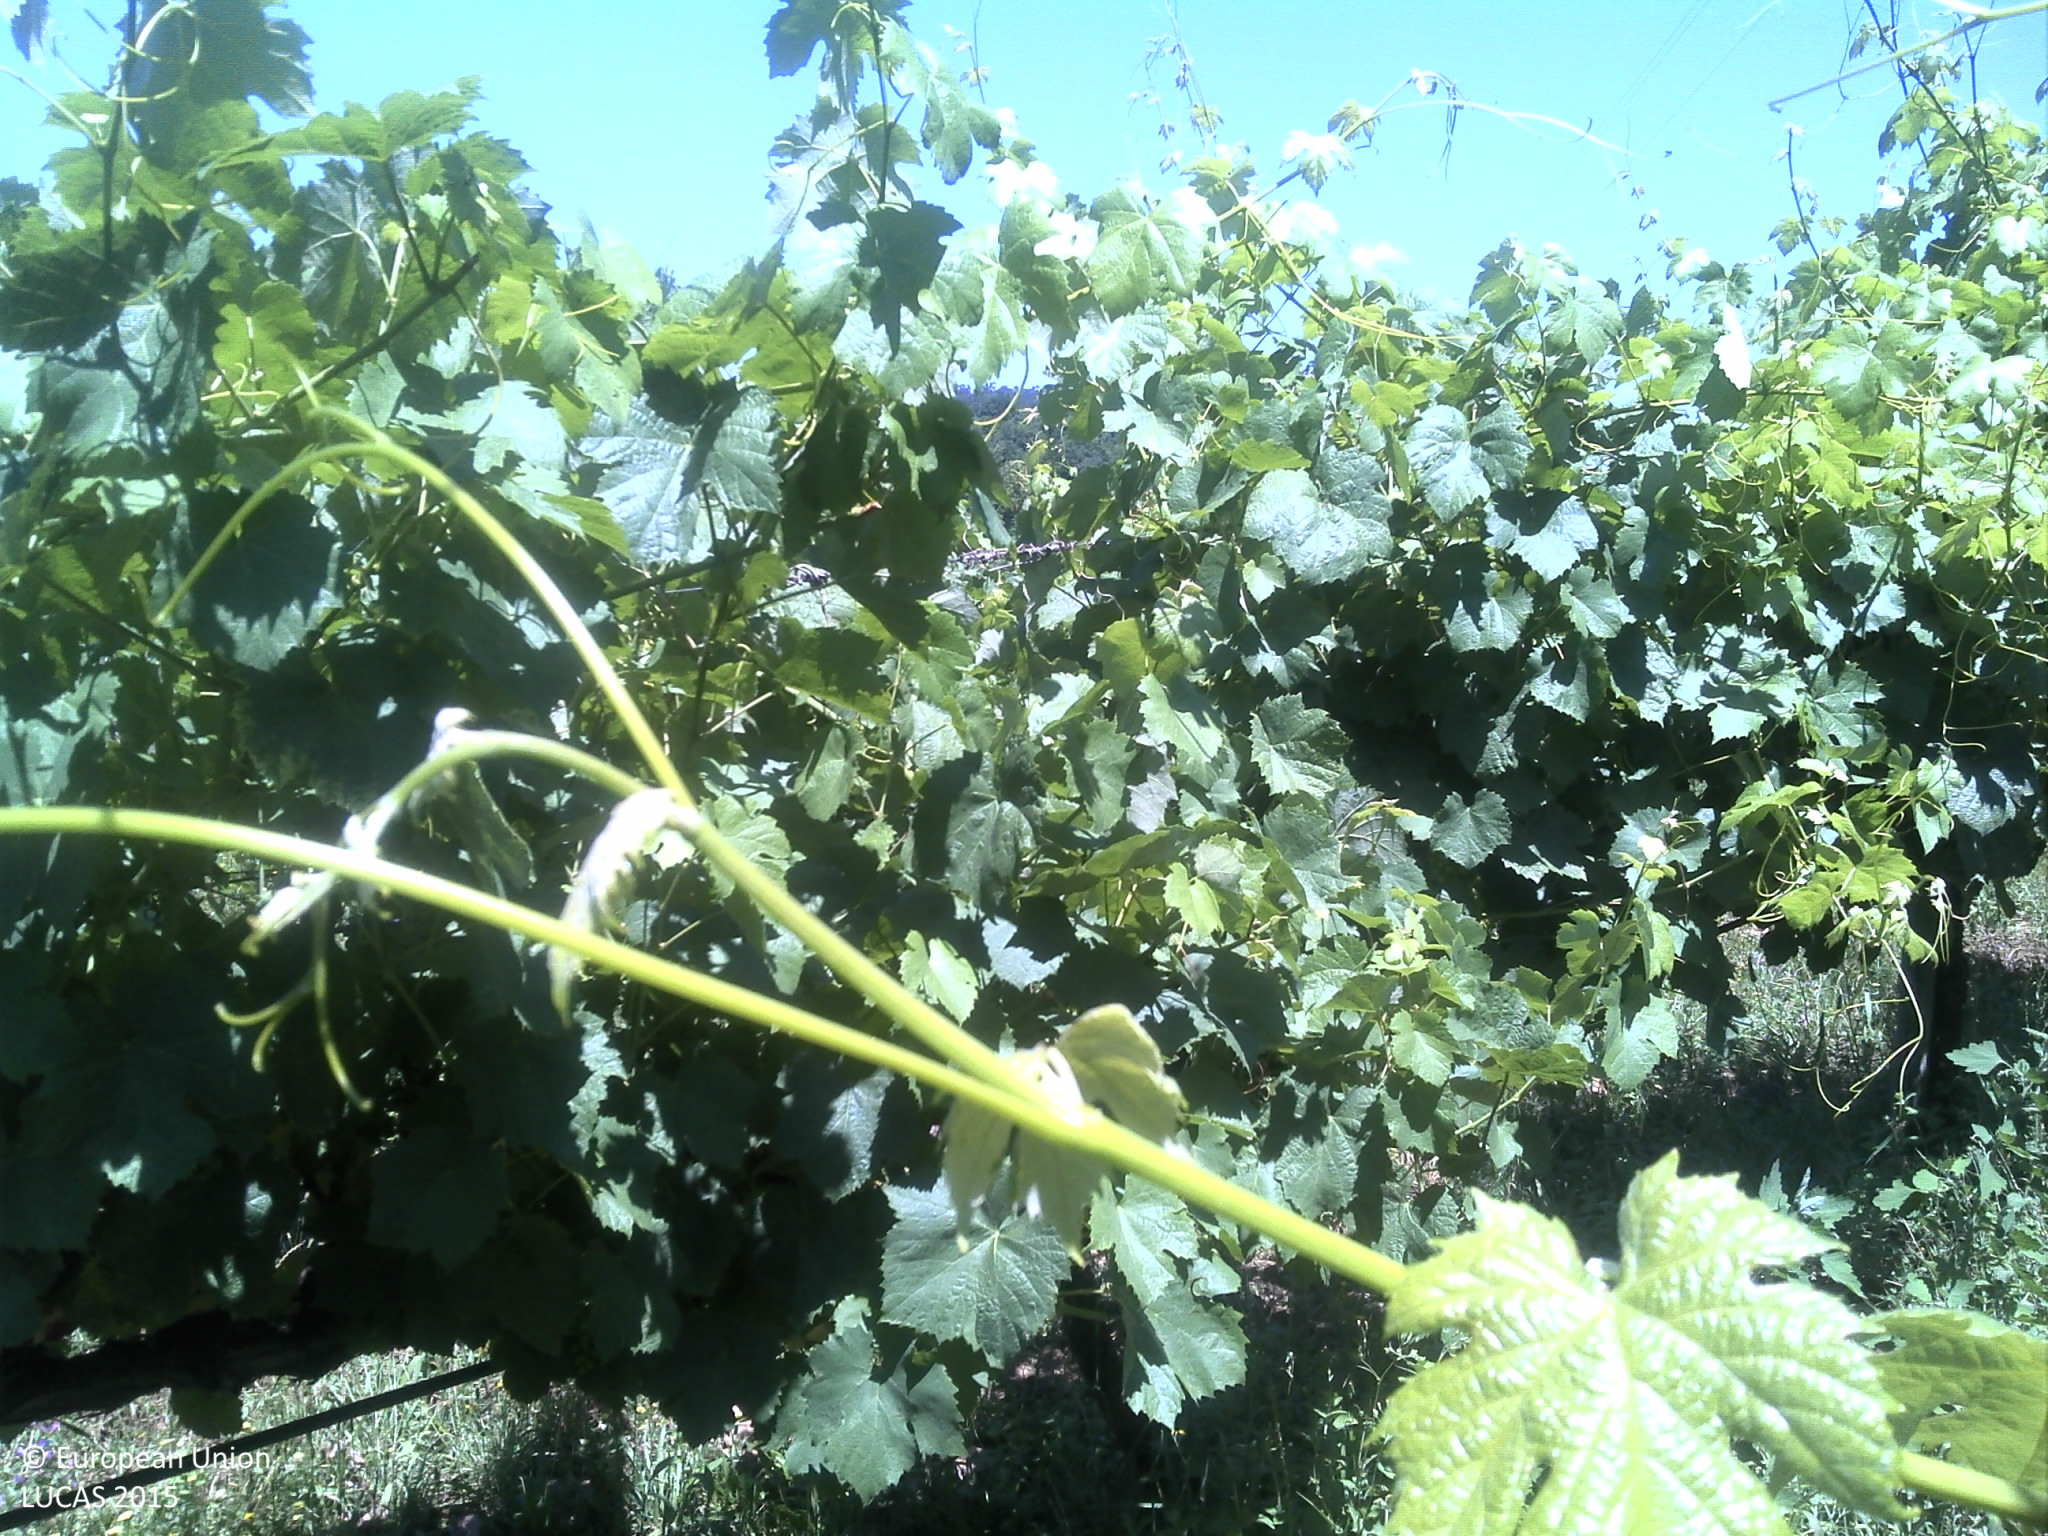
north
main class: Cropland
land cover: Vineyards
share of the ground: 25 - 50 %
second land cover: Grassland without tree/shrub cover
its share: > 75 %
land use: Agriculture (excluding fallow land and kitchen gardens)
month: June
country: PT
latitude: 41.3781
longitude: -7.9905
